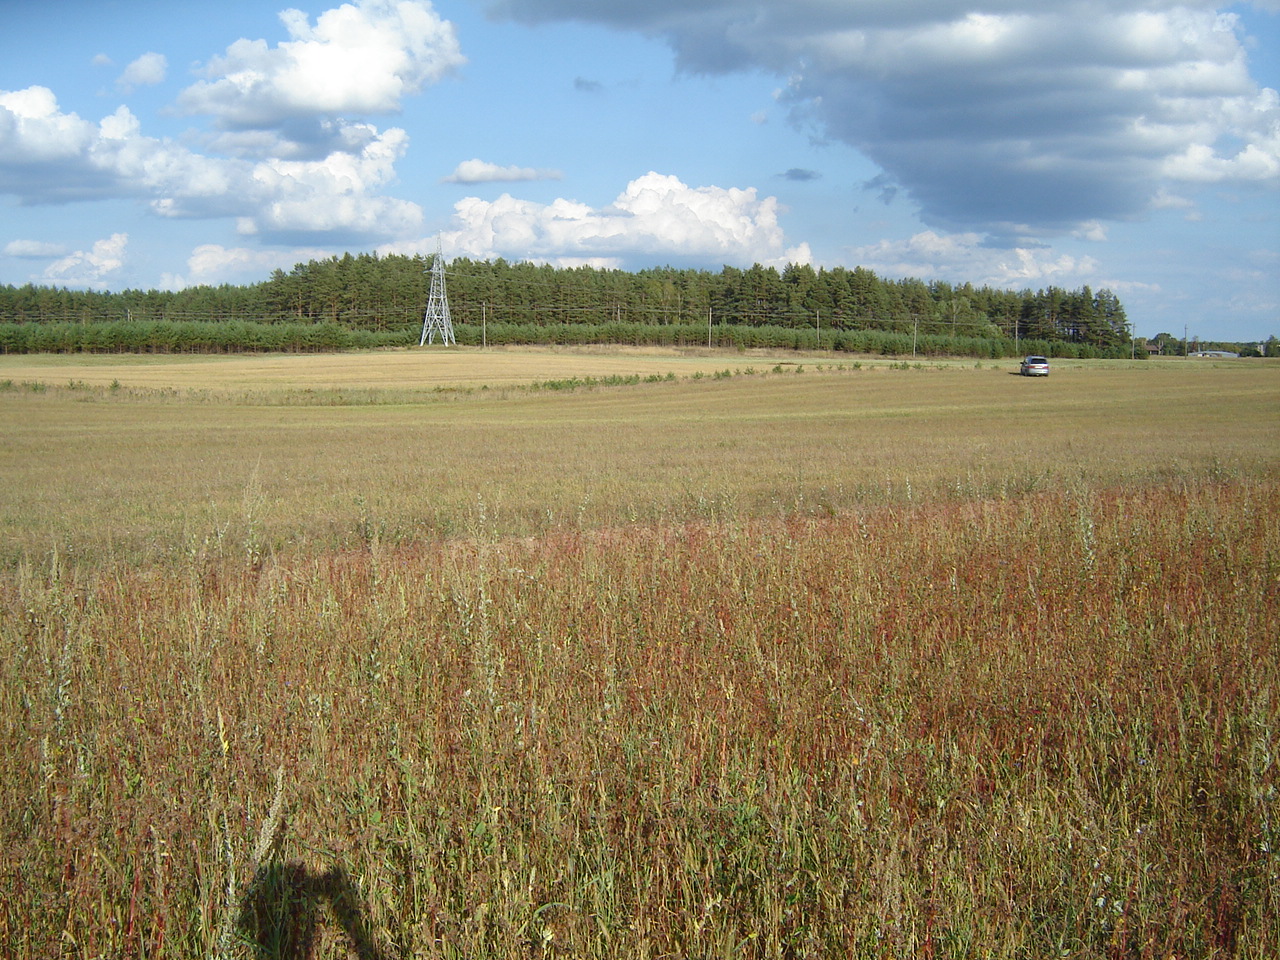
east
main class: Cropland
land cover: Other cereals
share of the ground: > 75 %
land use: Agriculture (excluding fallow land and kitchen gardens)
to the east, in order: Other cereals; Spontaneously vegetated surfaces; Grass margins; Tracks; Grass margins; Pine dominated coniferous woodland; Common wheat; Other cereals
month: August
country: LT
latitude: 54.5168
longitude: 24.8008
